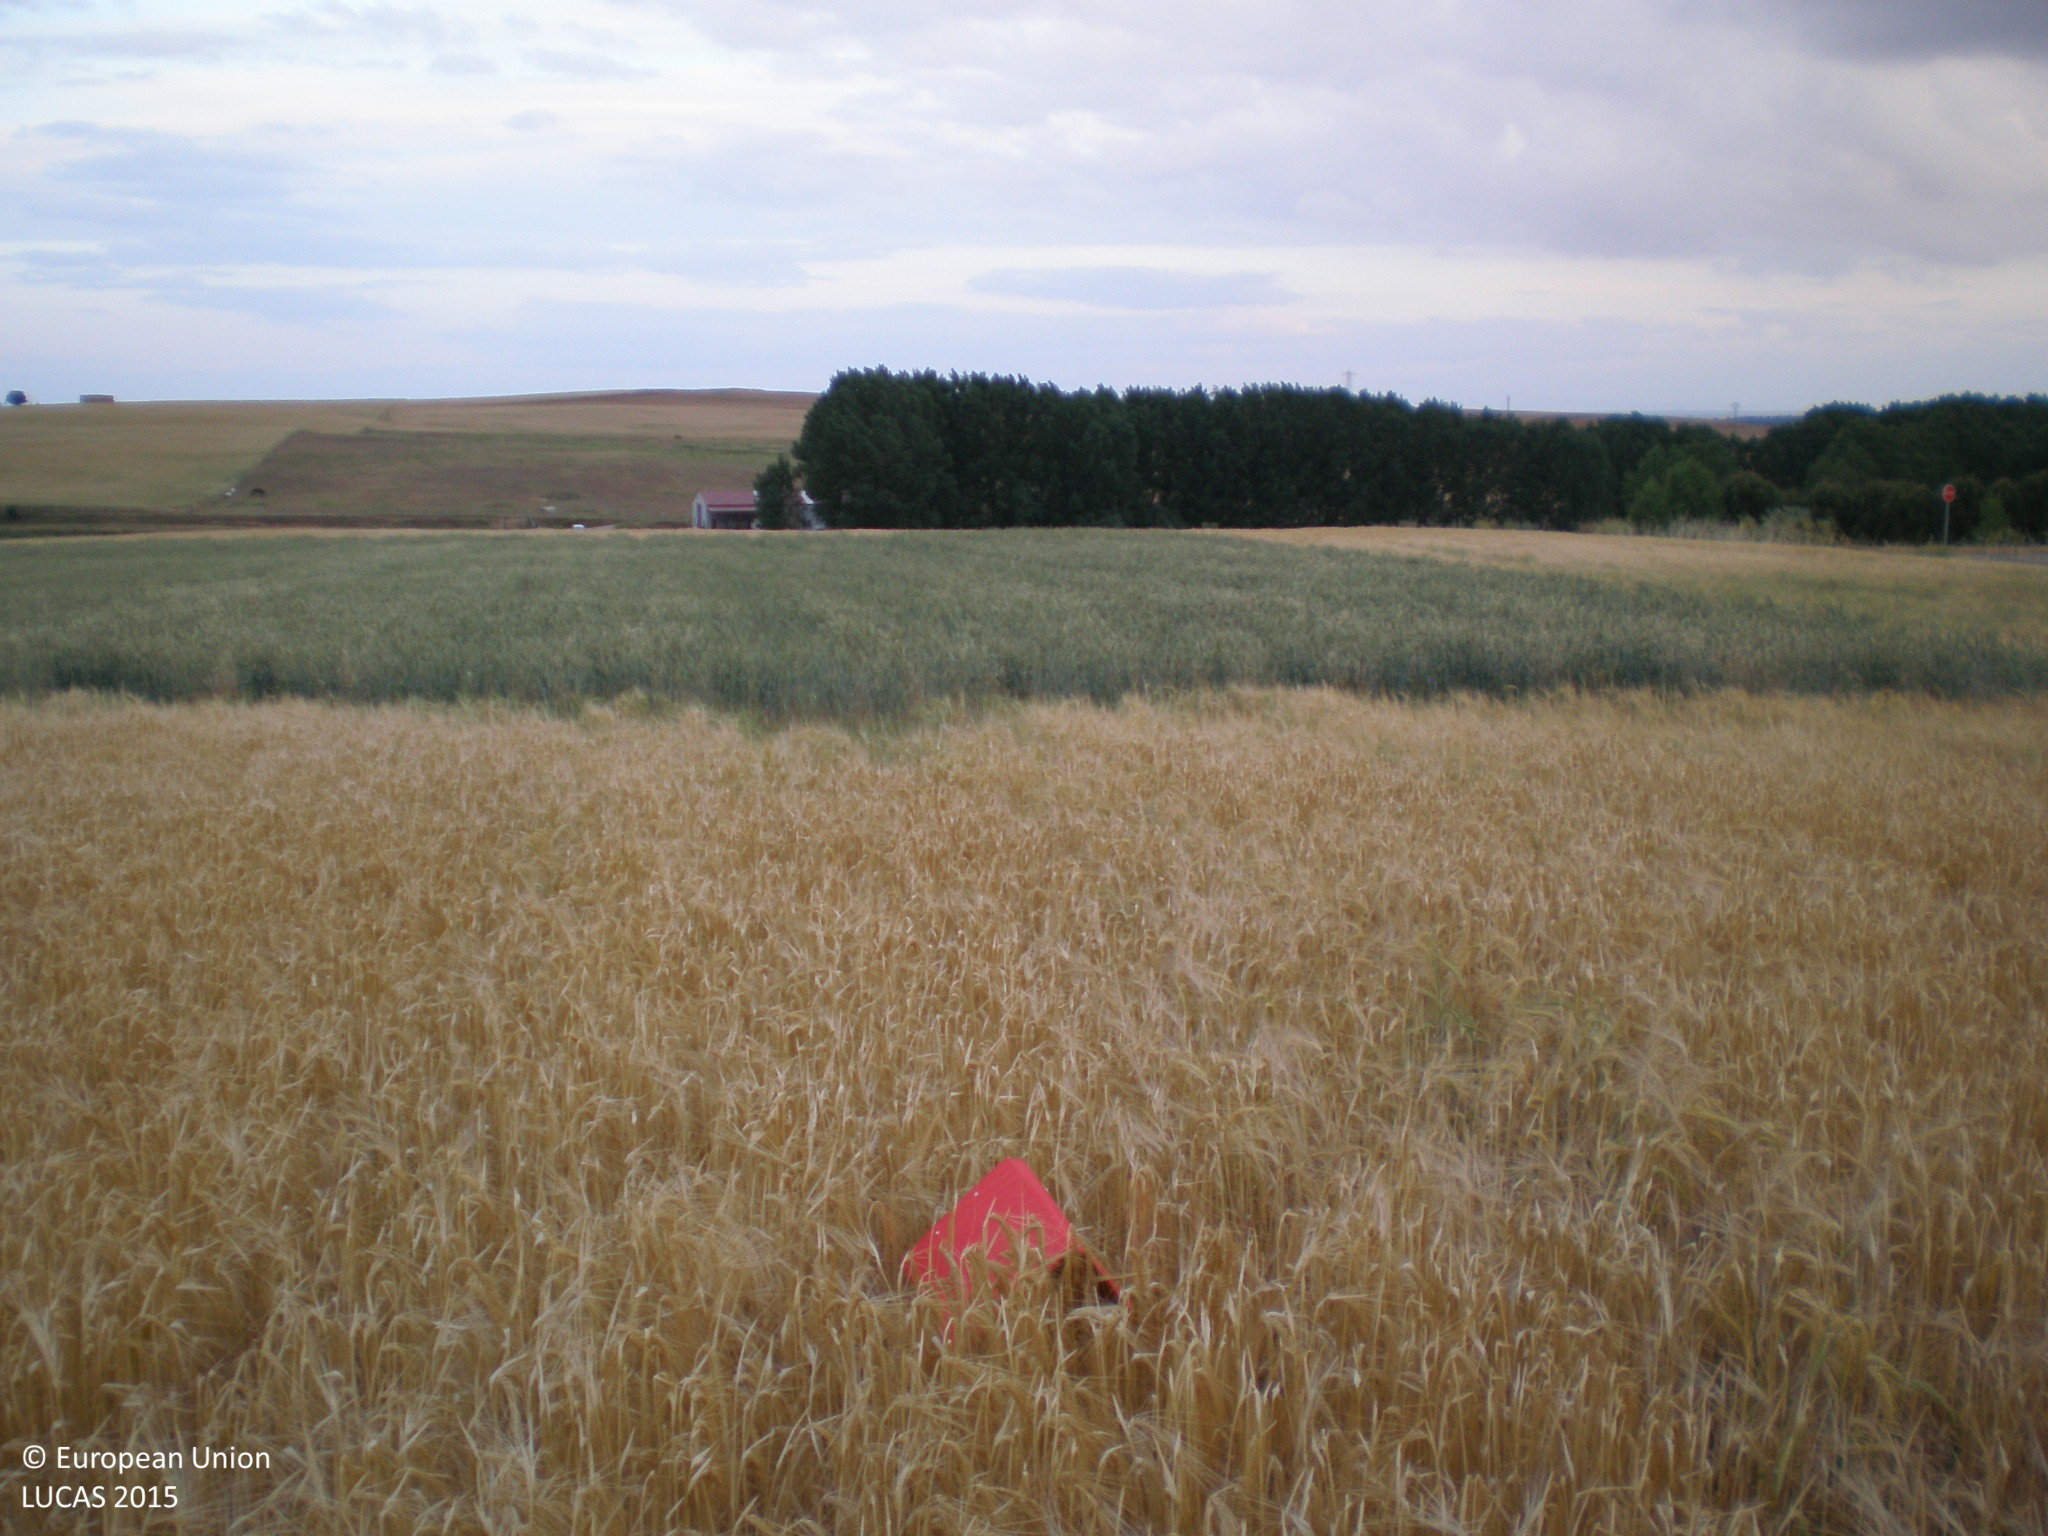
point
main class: Cropland
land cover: Barley
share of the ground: > 75 %
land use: Agriculture (excluding fallow land and kitchen gardens)
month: June
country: ES
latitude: 41.0596
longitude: -5.7759
